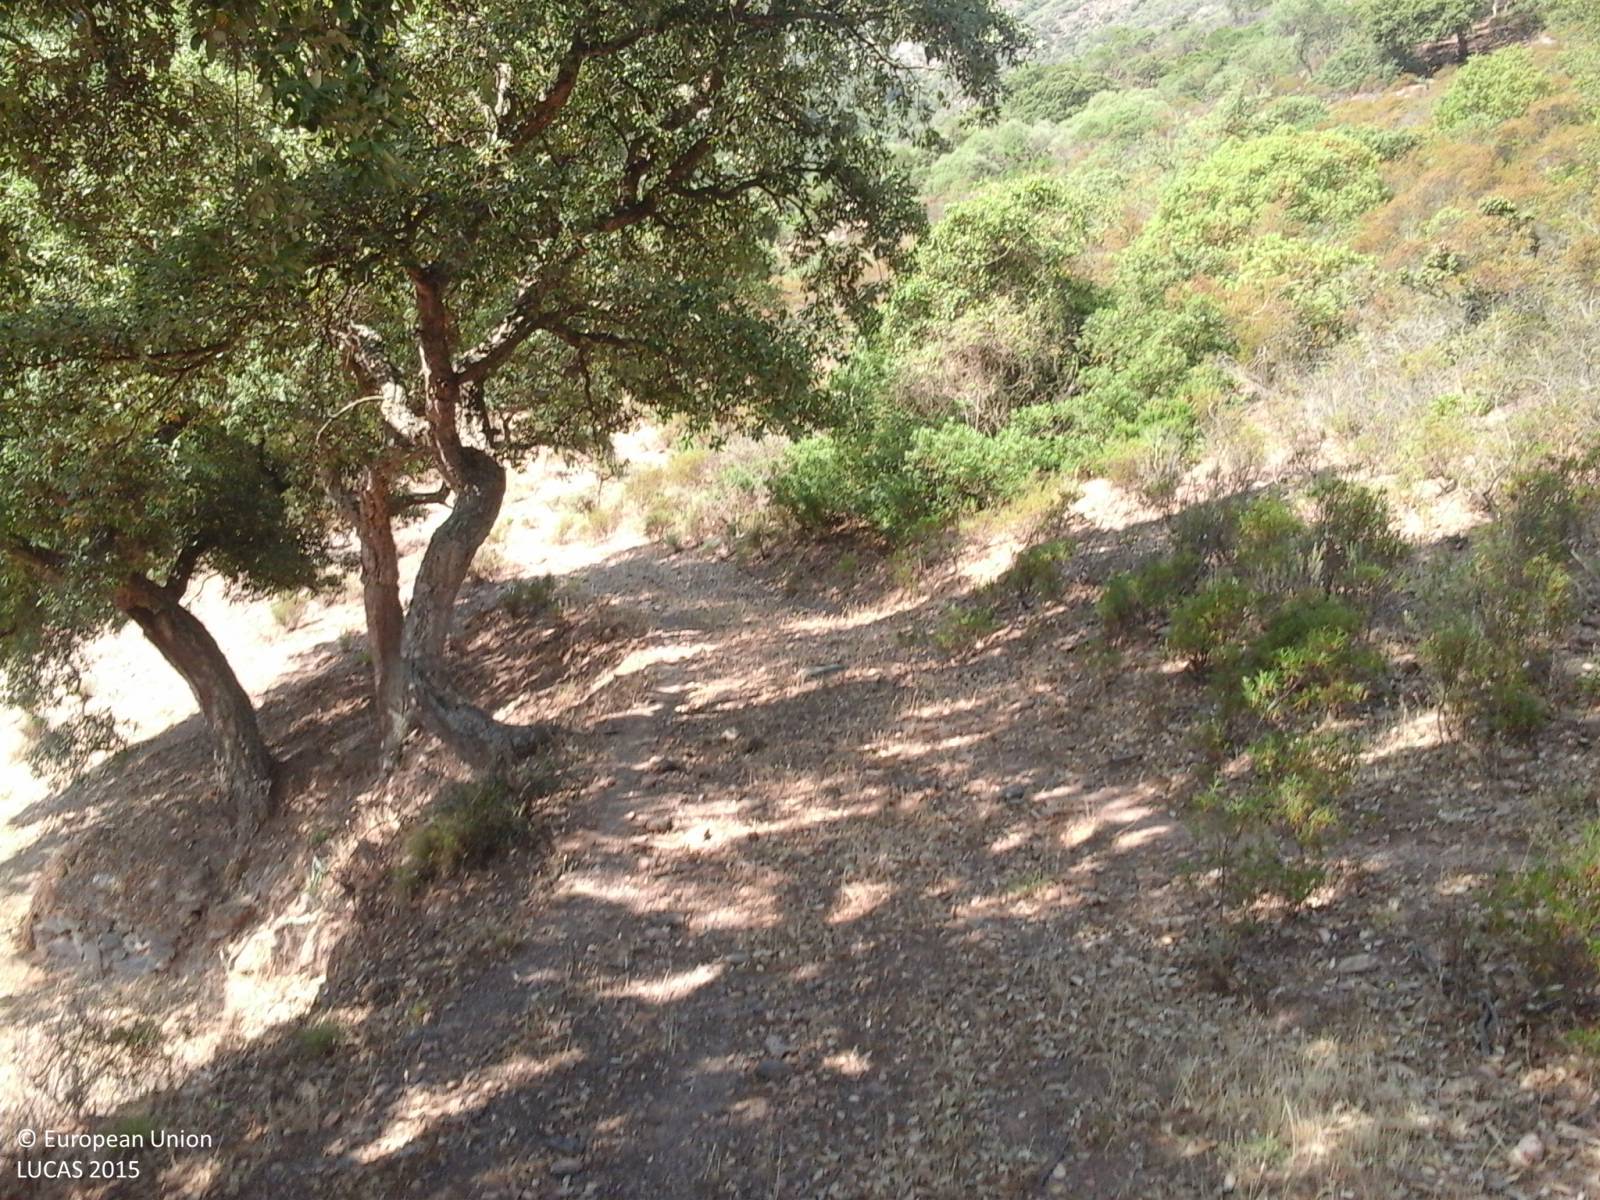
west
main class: Shrubland
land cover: Shrubland with sparse tree cover
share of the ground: > 75 %
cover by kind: shrubs 90 %, broadleaved forest trees 5 %, herbaceous plants 5 %
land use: Agriculture (excluding fallow land and kitchen gardens)
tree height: < 5 m
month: July
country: IT
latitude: 39.4402
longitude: 8.4638
